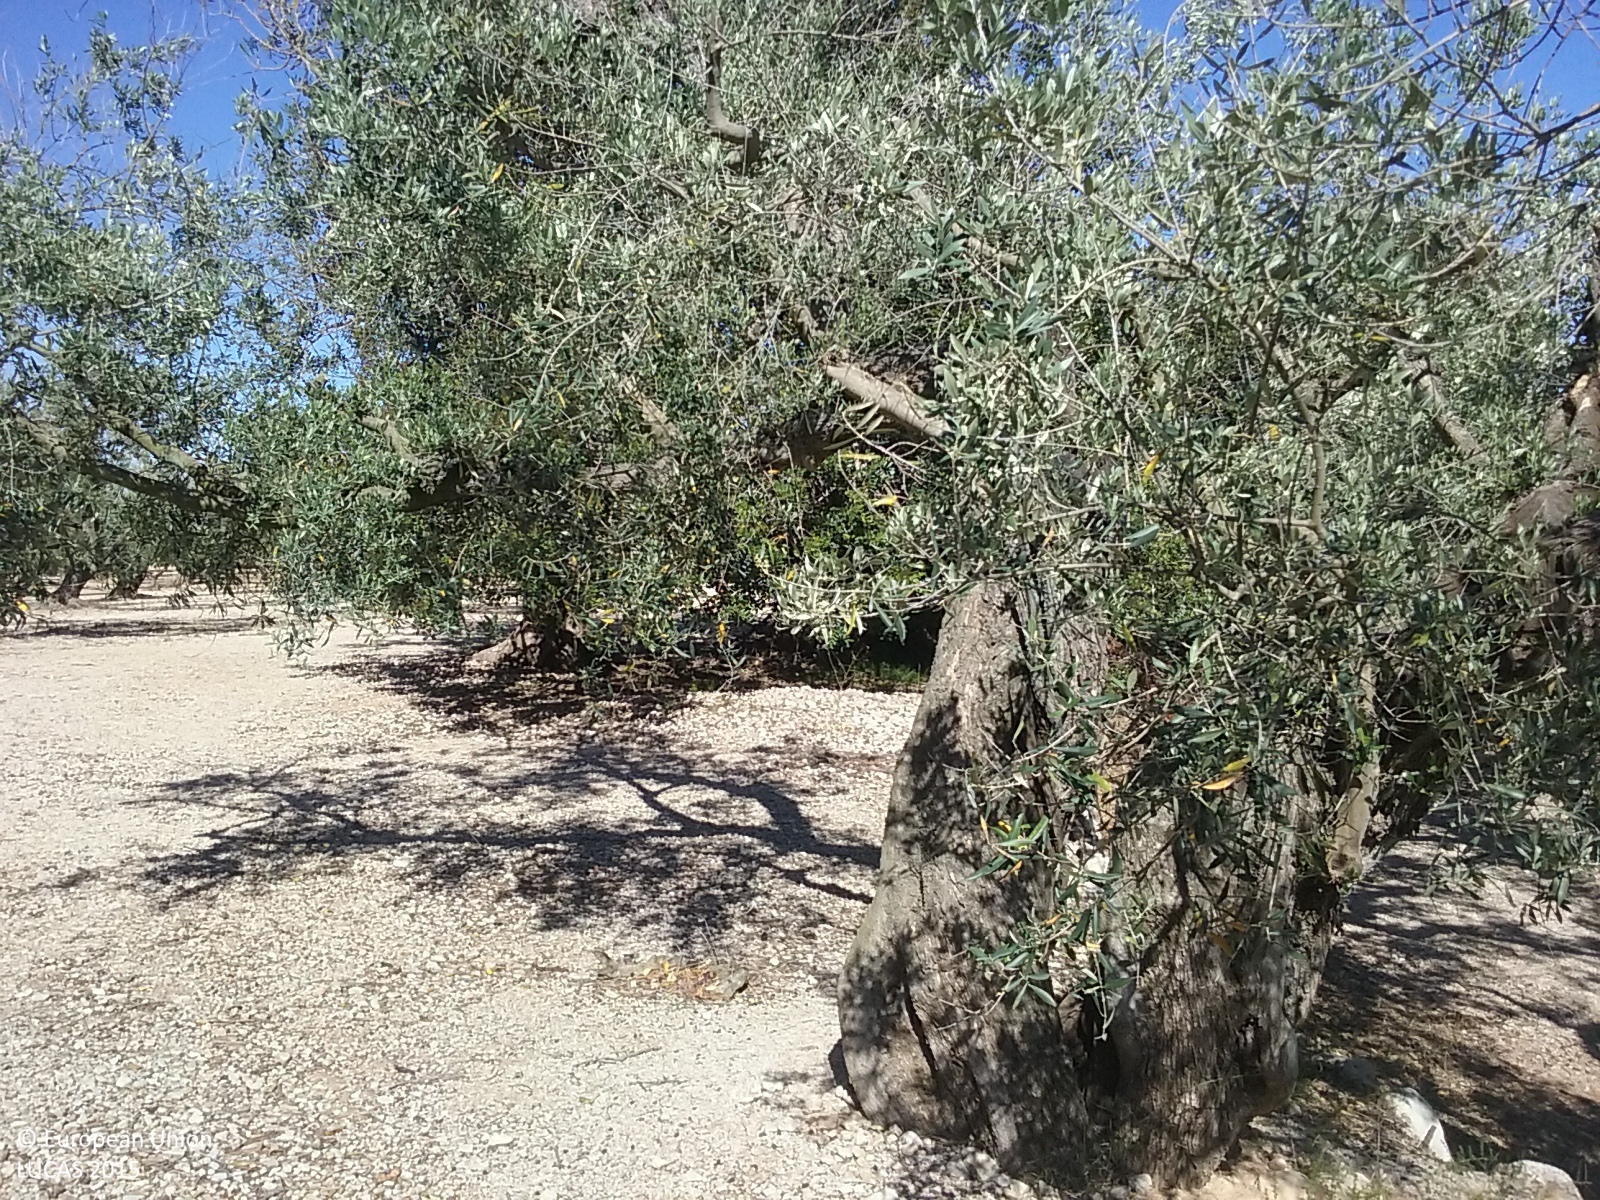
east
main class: Cropland
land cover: Olive groves
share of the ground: 50 - 75 %
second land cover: Other bare soil
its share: > 75 %
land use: Agriculture (excluding fallow land and kitchen gardens)
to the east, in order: Dry stone walls; Olive groves; Other bare soil; Dry stone walls; Olive groves; Tracks; Olive groves; Dry stone walls; Olive groves; Dry stone walls; Olive groves
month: May
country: ES
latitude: 40.7816
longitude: 0.4312
